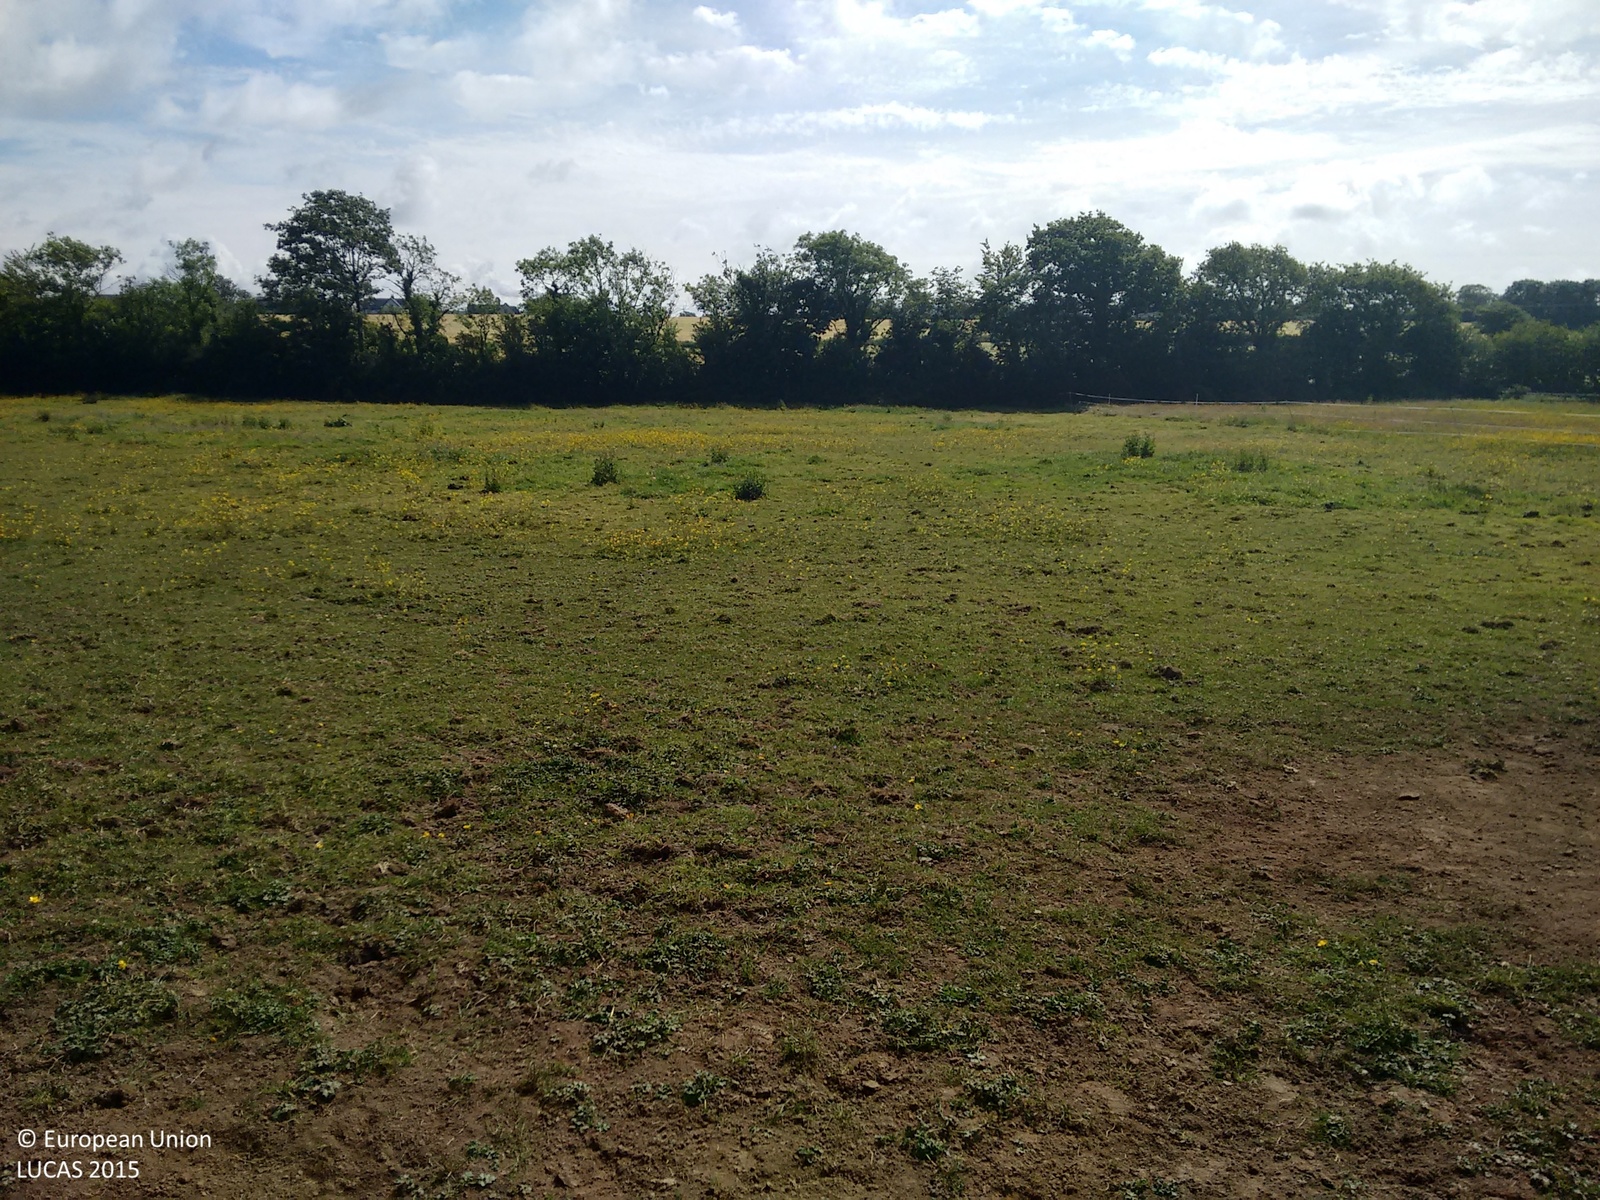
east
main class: Grassland
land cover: Grassland without tree/shrub cover
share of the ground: > 75 %
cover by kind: herbaceous plants 100 %
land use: Agriculture (excluding fallow land and kitchen gardens)
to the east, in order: Grassland without tree/shrub cover; Abandoned hedges; Ditches and canals; Barley; Abandoned hedges; Electric lines; Barley
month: June
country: IE
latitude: 52.2684
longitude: -7.0703
